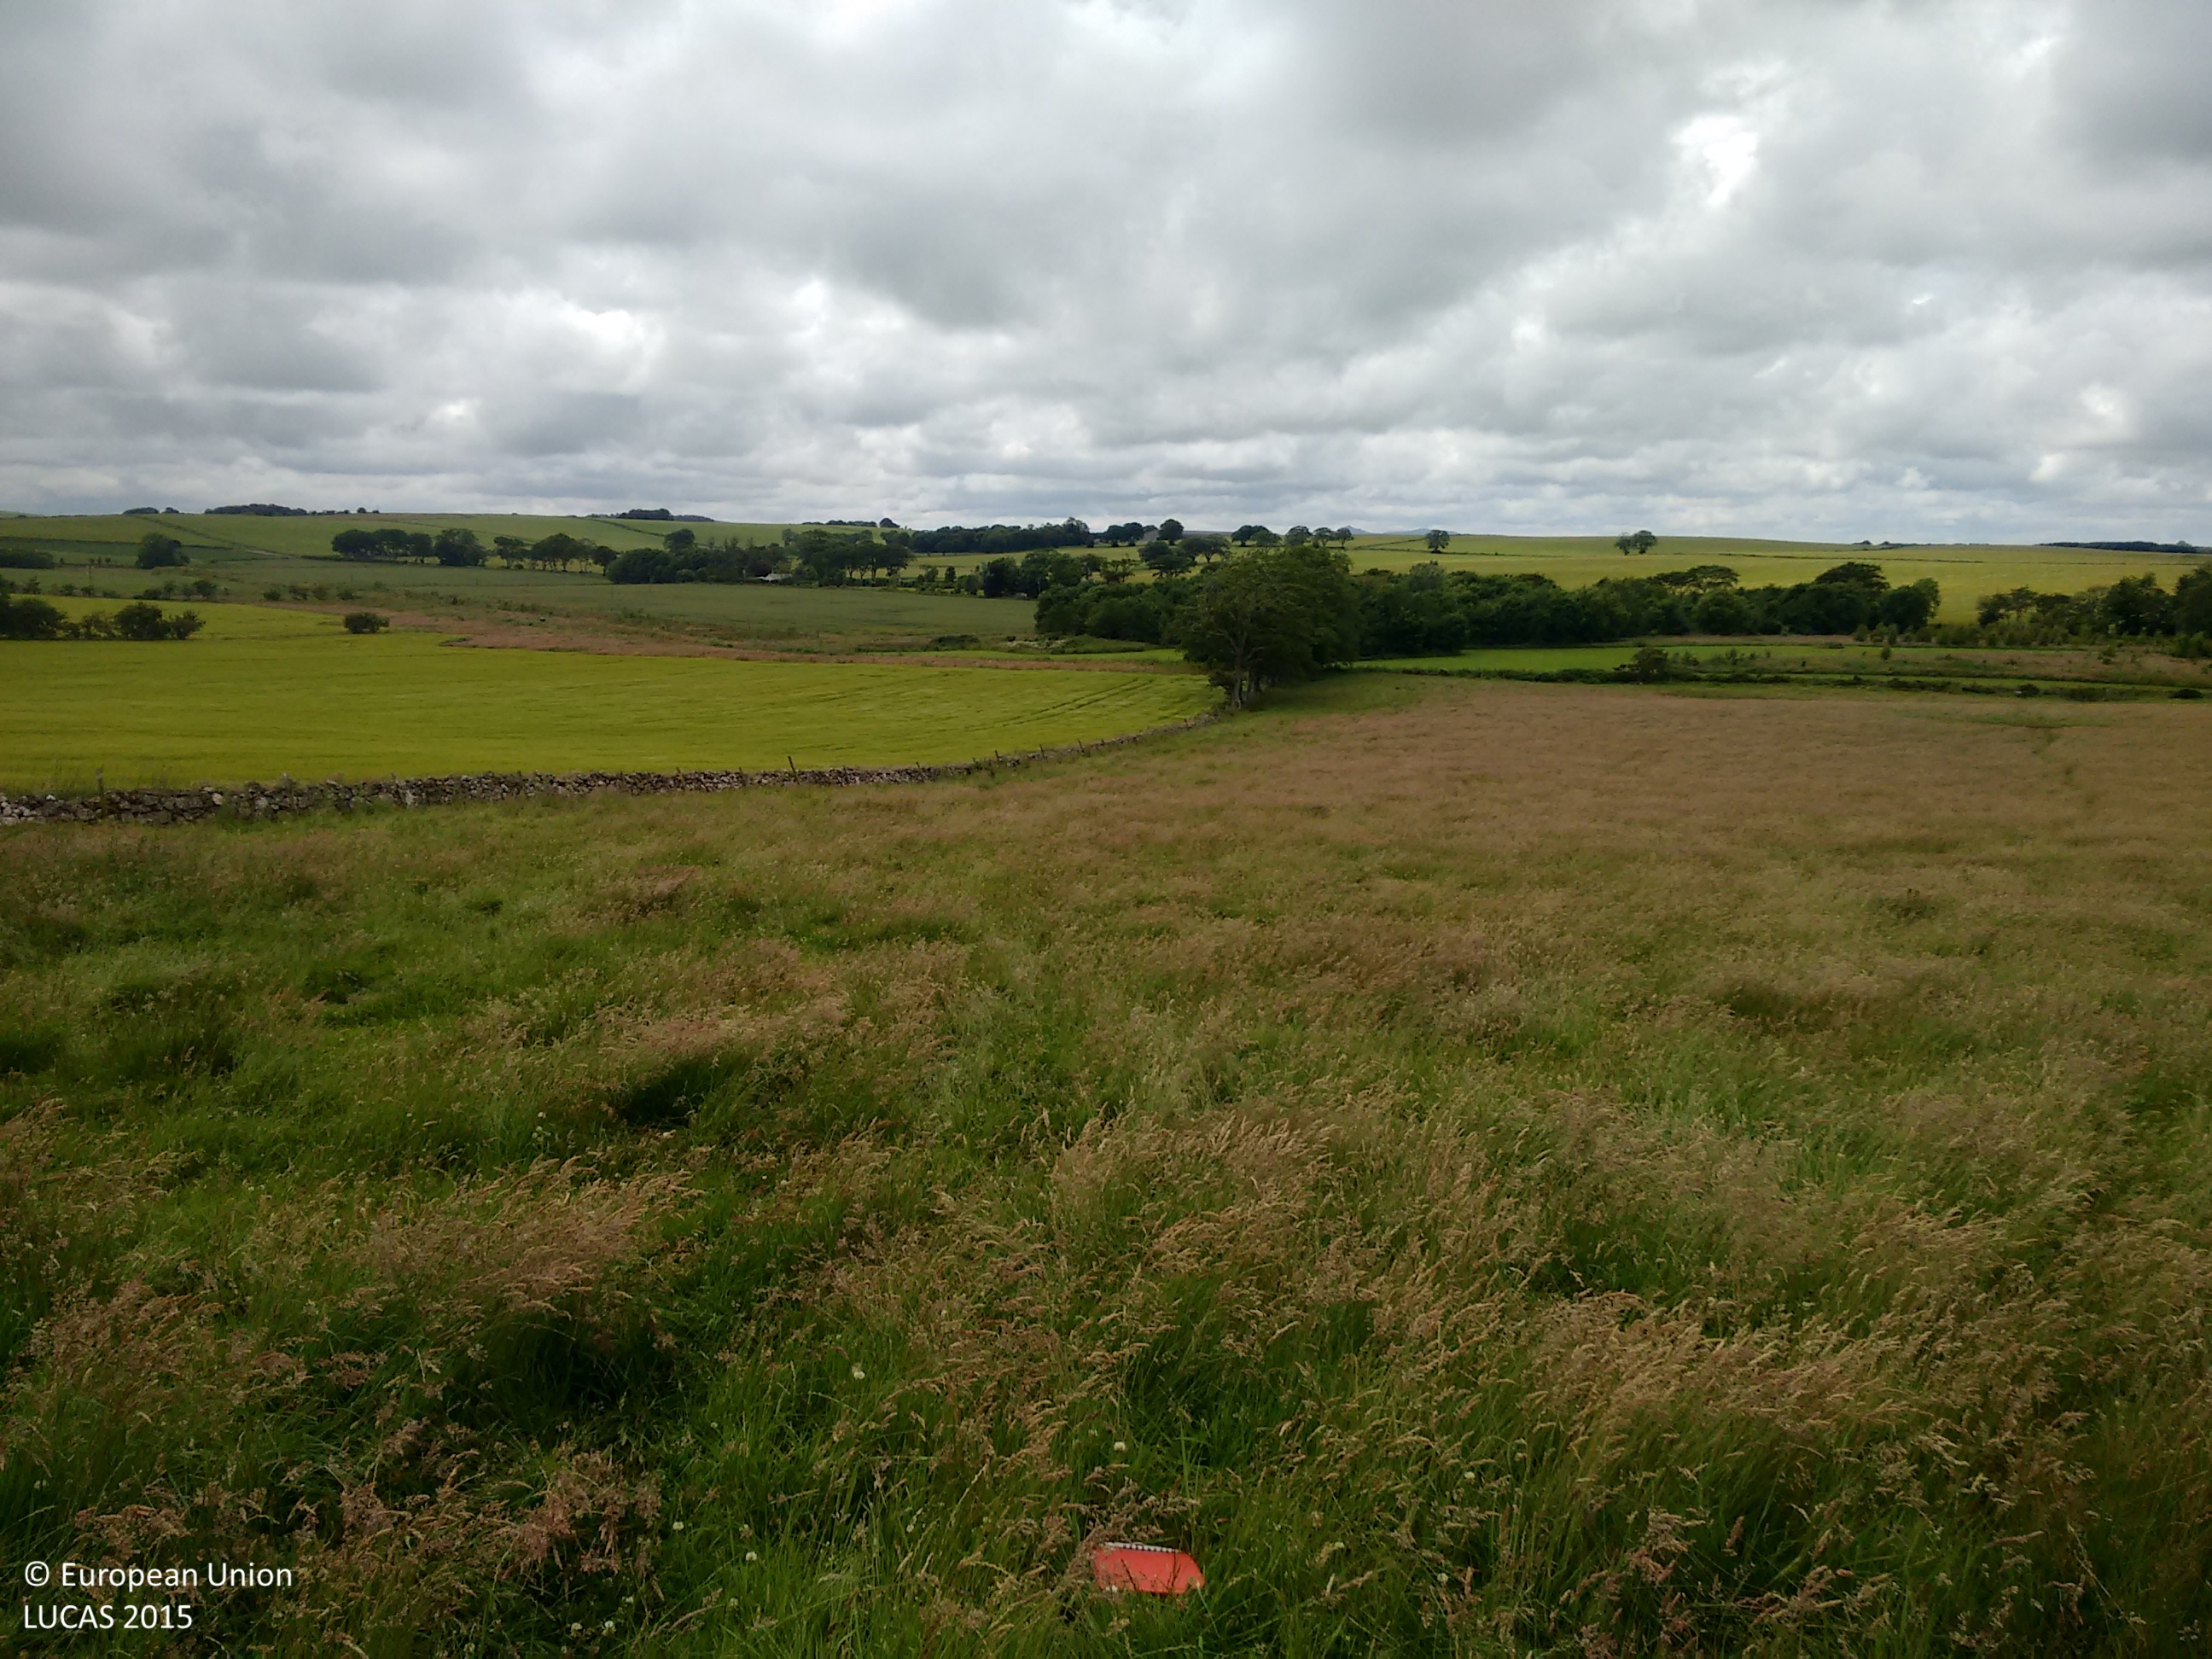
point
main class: Grassland
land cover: Grassland without tree/shrub cover
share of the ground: > 75 %
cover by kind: herbaceous plants 100 %
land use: Agriculture (excluding fallow land and kitchen gardens)
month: July
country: GB
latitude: 57.3486
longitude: -2.2305
